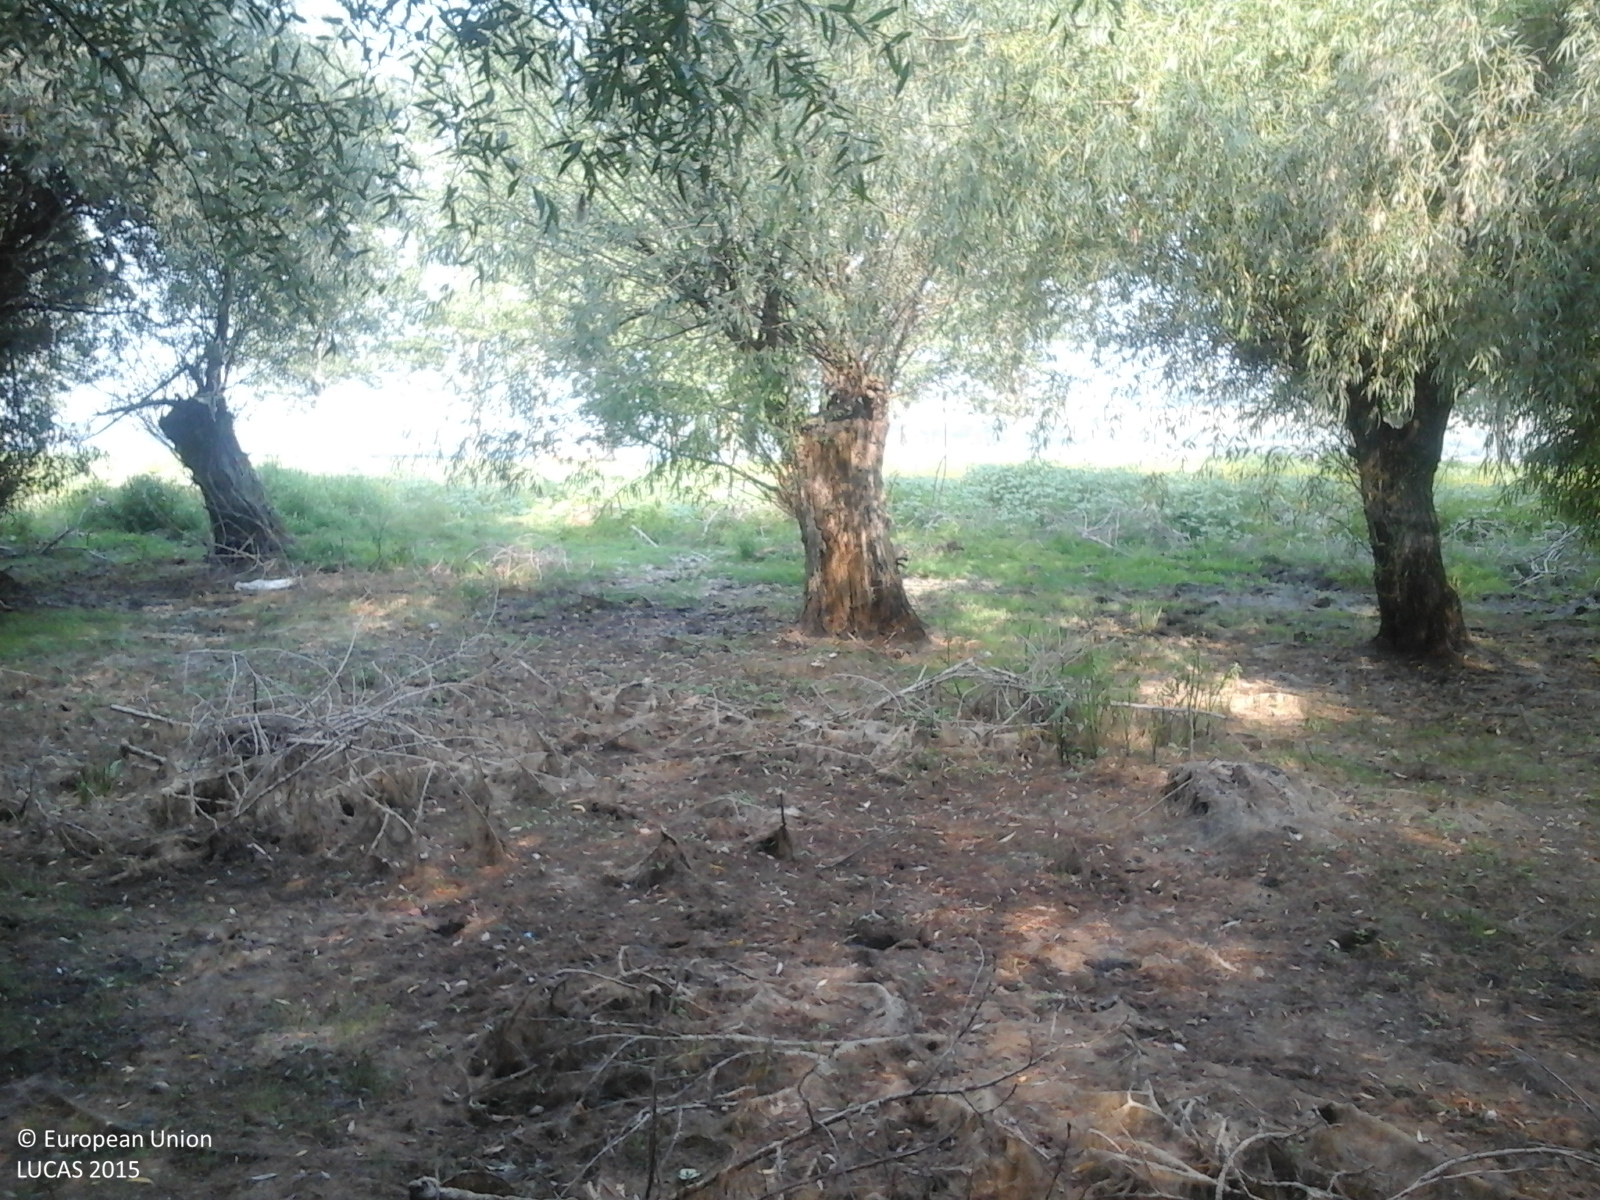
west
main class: Woodland
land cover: Broadleaved woodland
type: floodplain forest
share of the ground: > 75 %
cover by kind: broadleaved forest trees 100 %
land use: Forestry
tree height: > 5 m
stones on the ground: < 10 %
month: July
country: RO
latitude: 45.4085
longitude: 28.0443
